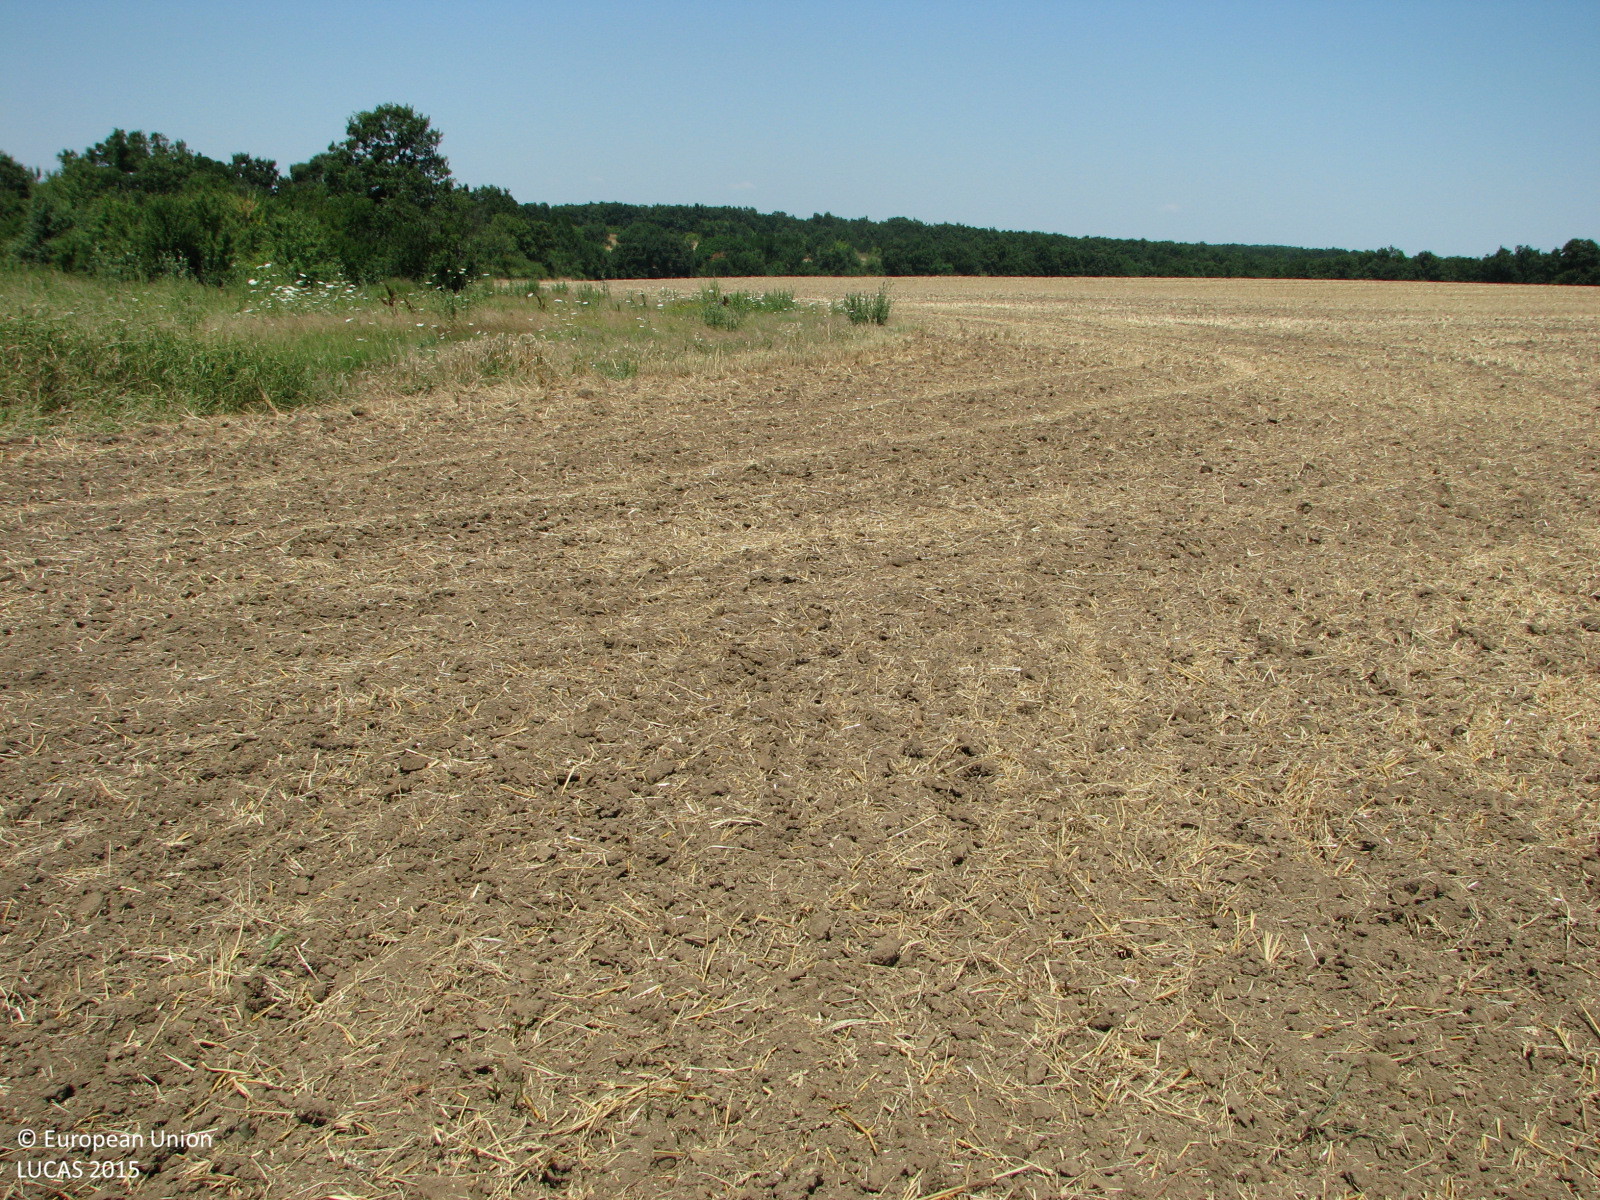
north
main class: Cropland
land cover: Common wheat
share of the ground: < 10 %
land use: Agriculture (excluding fallow land and kitchen gardens)
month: July
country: BG
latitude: 42.2240
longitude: 26.8528
